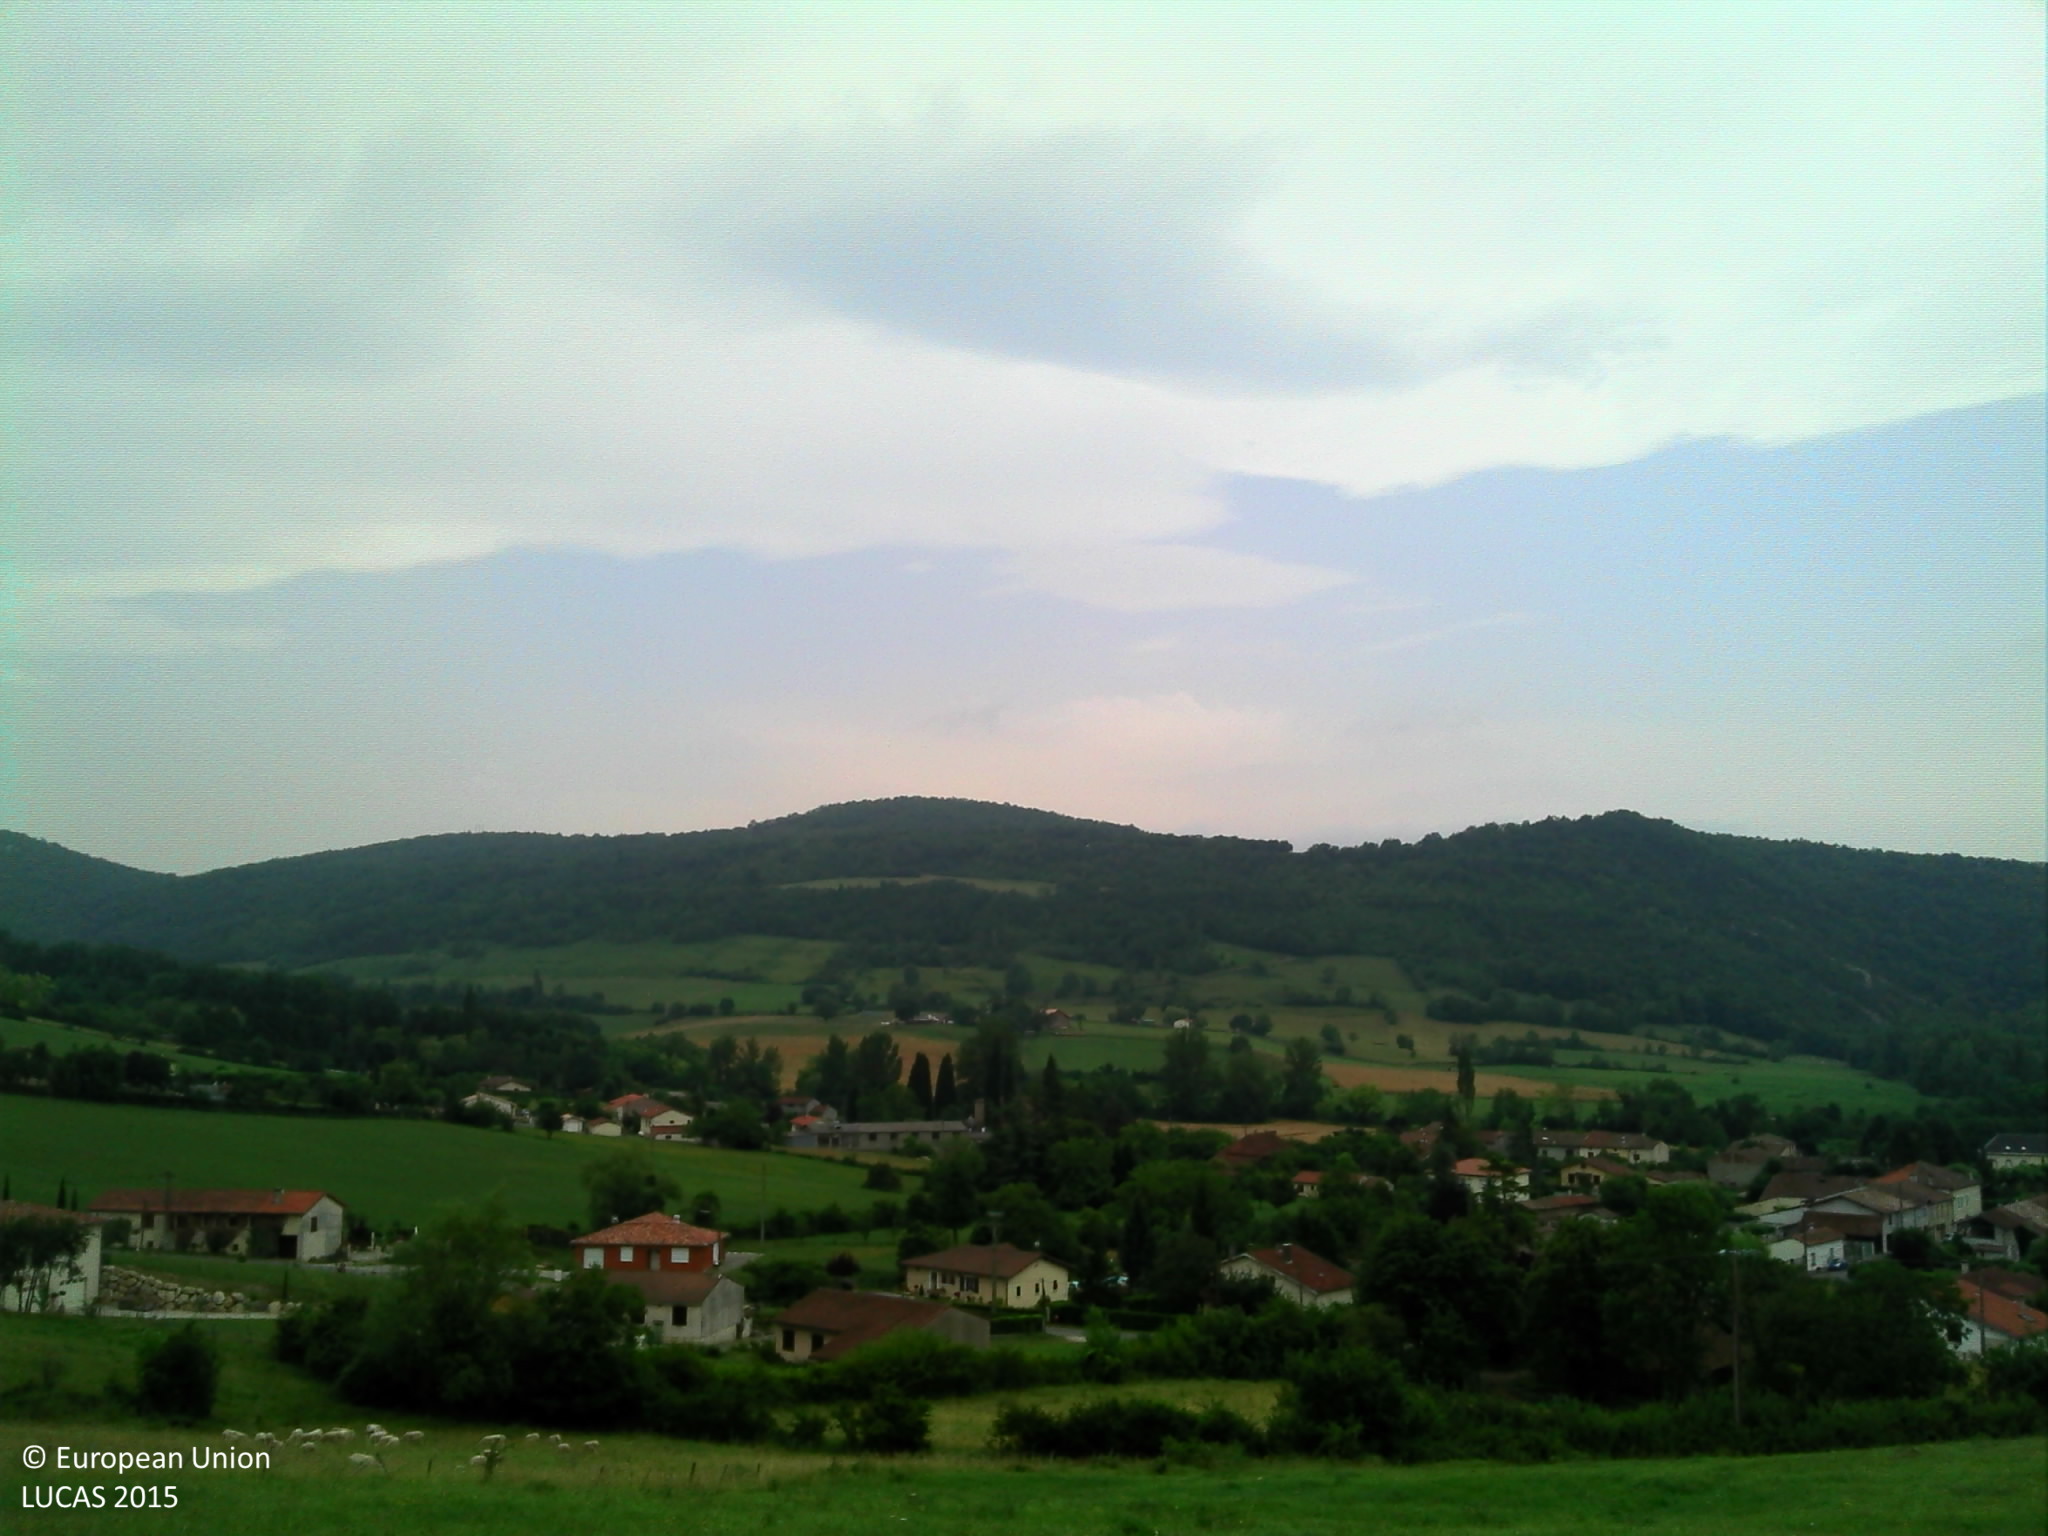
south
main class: Grassland
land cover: Grassland without tree/shrub cover
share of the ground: > 75 %
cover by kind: herbaceous plants 100 %
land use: Agriculture (excluding fallow land and kitchen gardens)
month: July
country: FR
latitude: 43.1036
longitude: 1.3917
